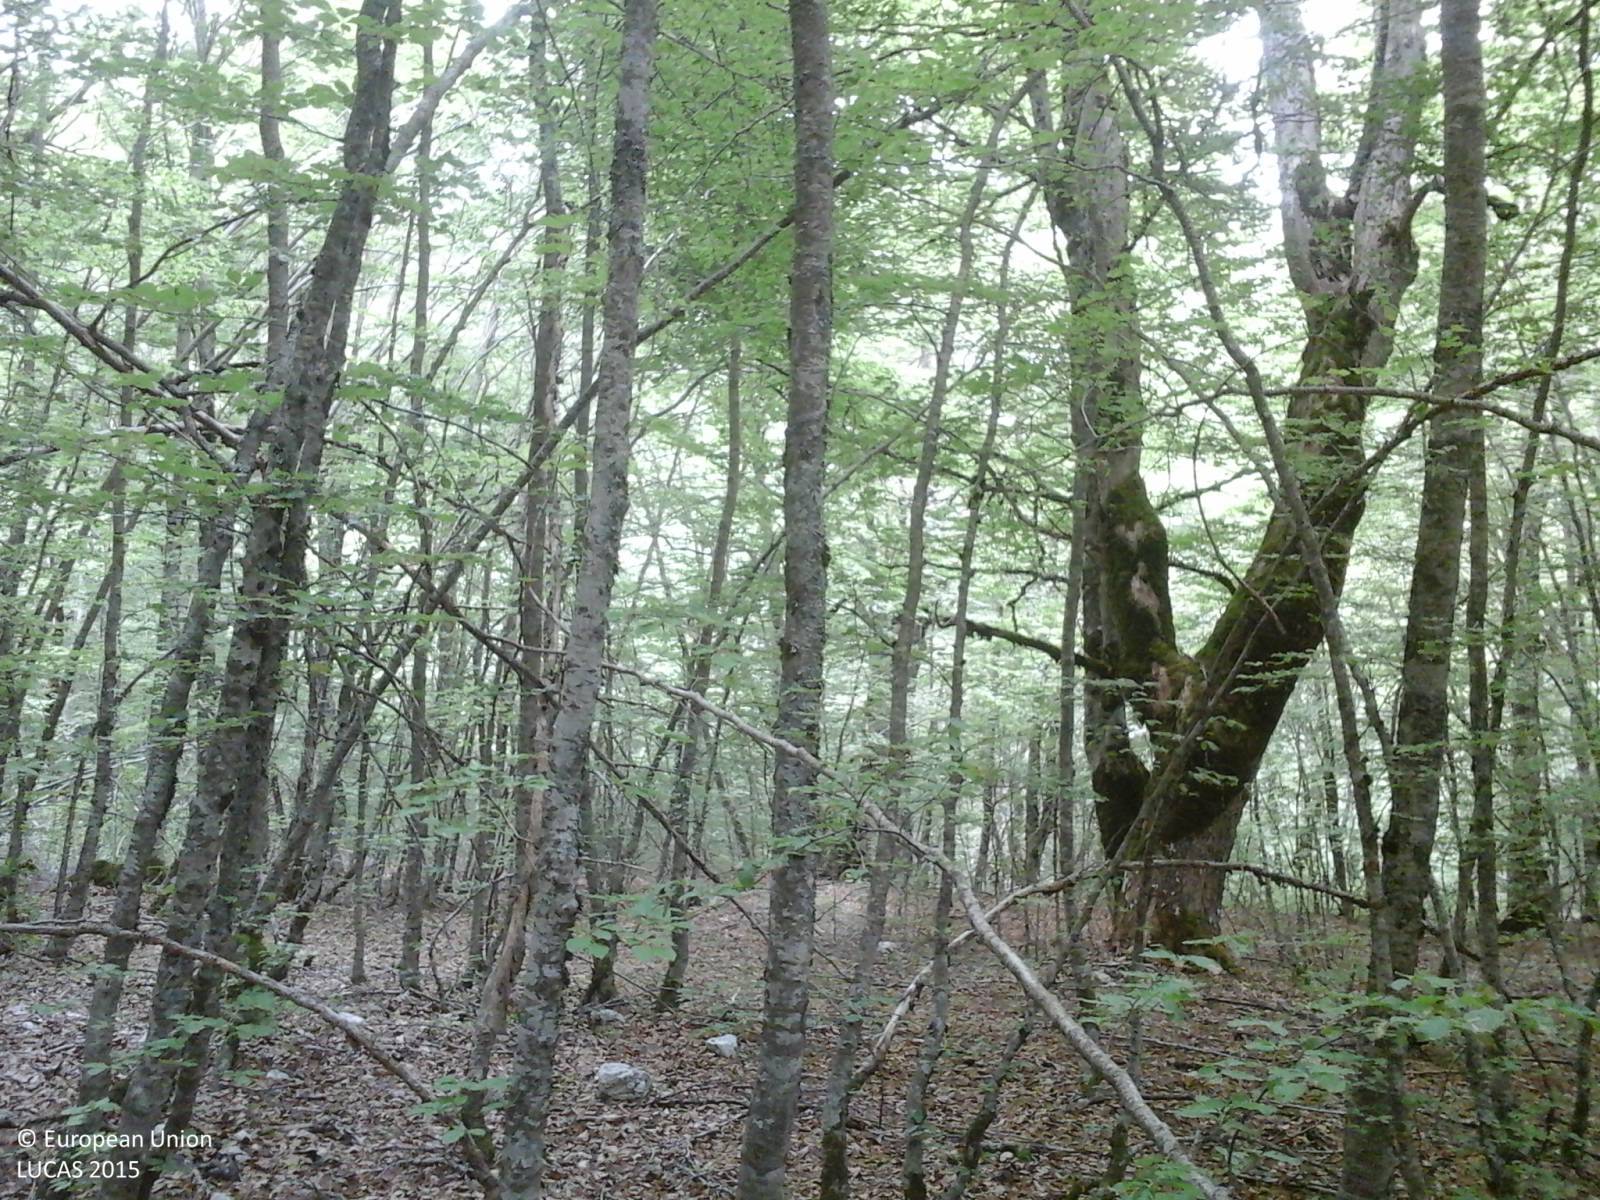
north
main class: Woodland
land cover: Broadleaved woodland
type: mountainous beech forest
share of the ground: > 75 %
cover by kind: broadleaved forest trees 100 %
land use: Forestry
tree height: > 5 m
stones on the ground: 10 - 25 %
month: May
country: IT
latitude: 41.8610
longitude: 13.7574
